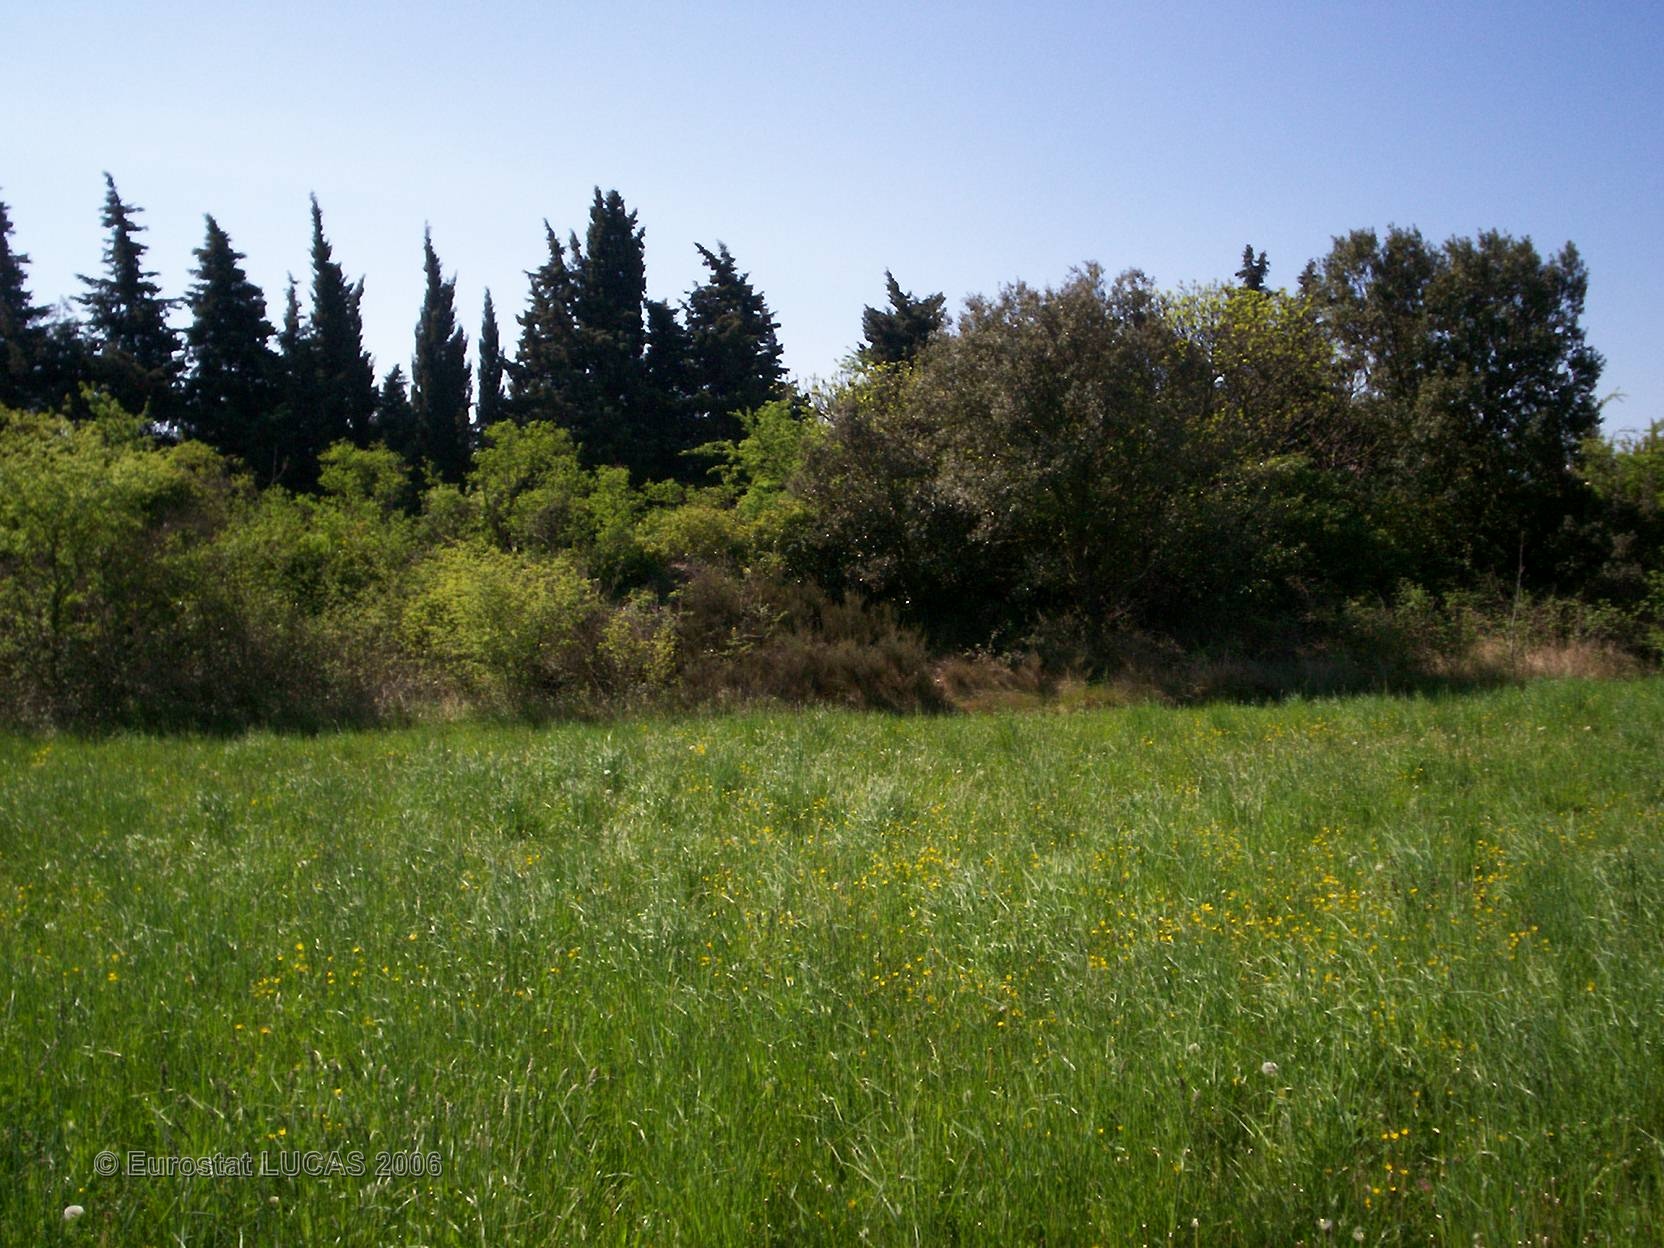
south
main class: Grassland
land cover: Grassland without tree/shrub cover
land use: Agriculture (excluding fallow land and kitchen gardens)
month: April
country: FR
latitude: 43.5839
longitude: 5.0930
